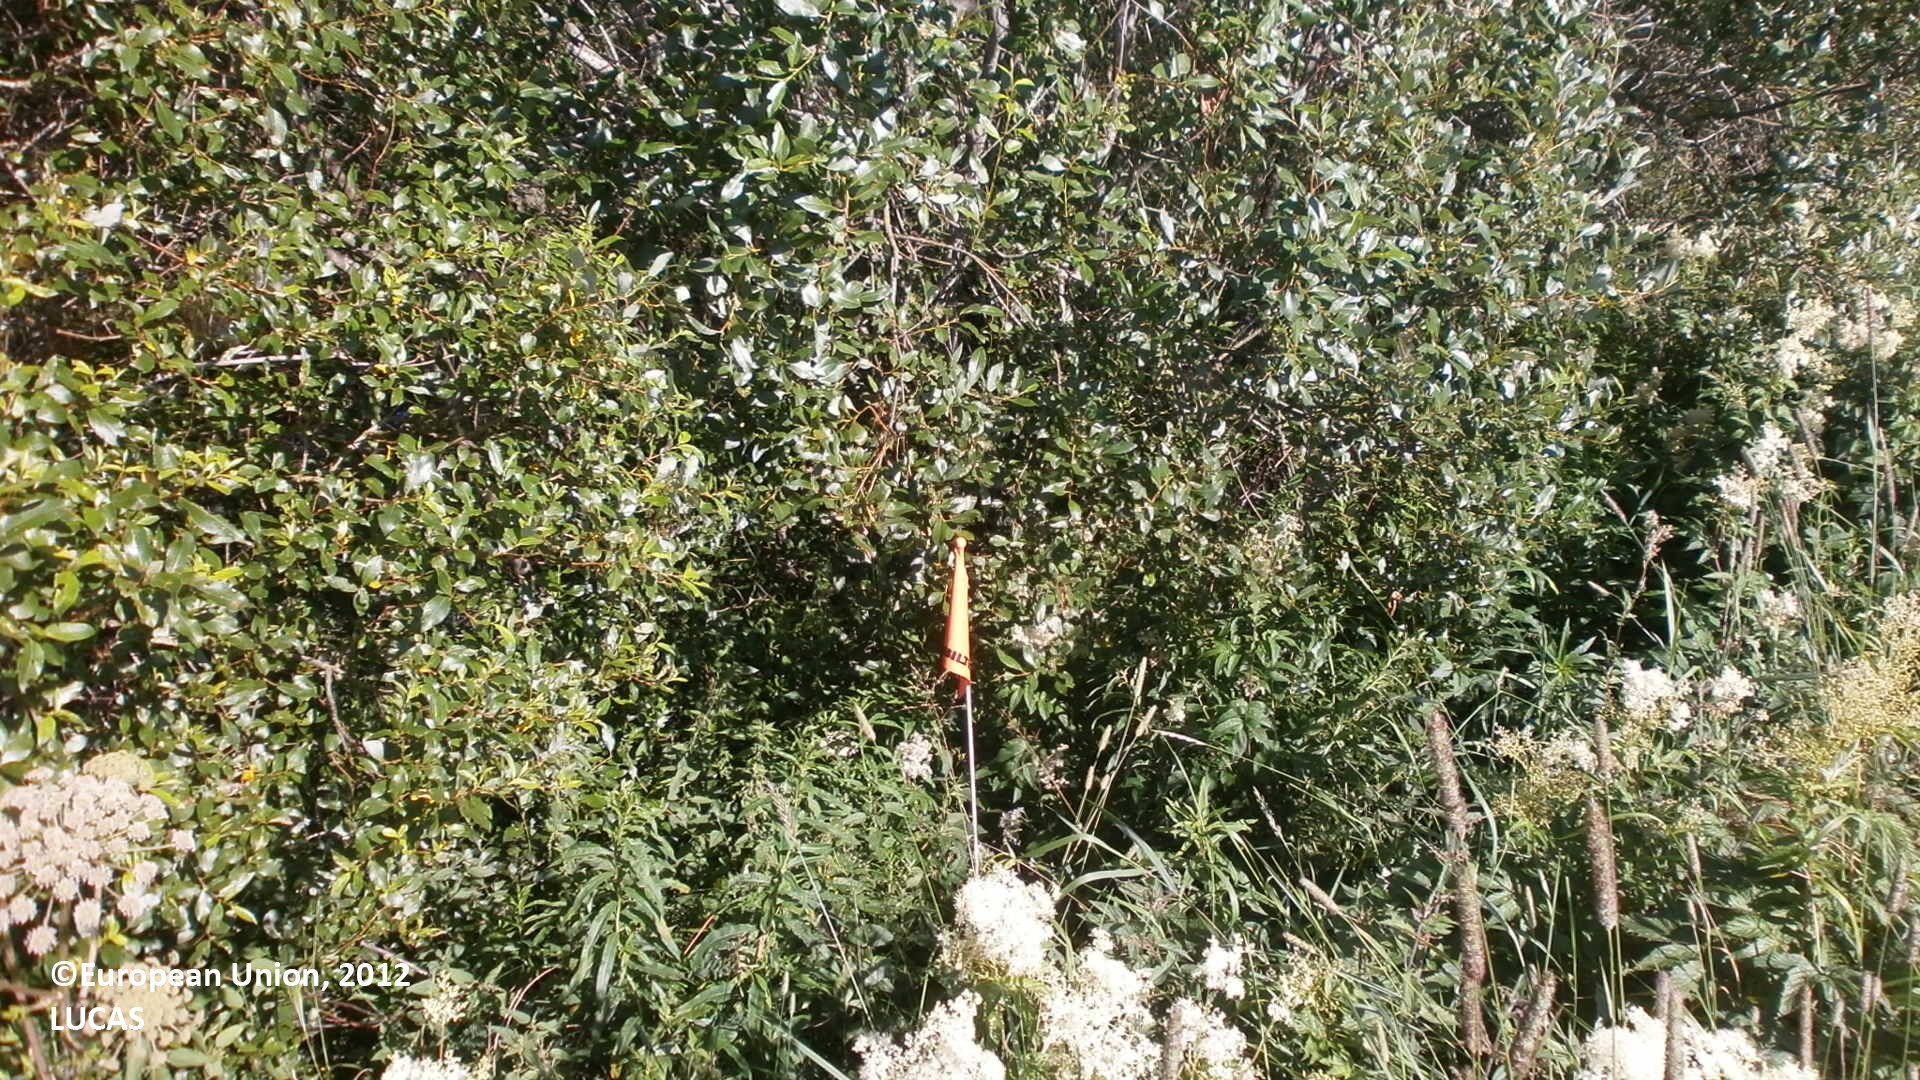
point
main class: Shrubland
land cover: Shrubland without tree cover
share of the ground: > 75 %
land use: Agriculture (excluding fallow land and kitchen gardens)
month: July
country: FI
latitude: 64.1437
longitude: 23.9768
